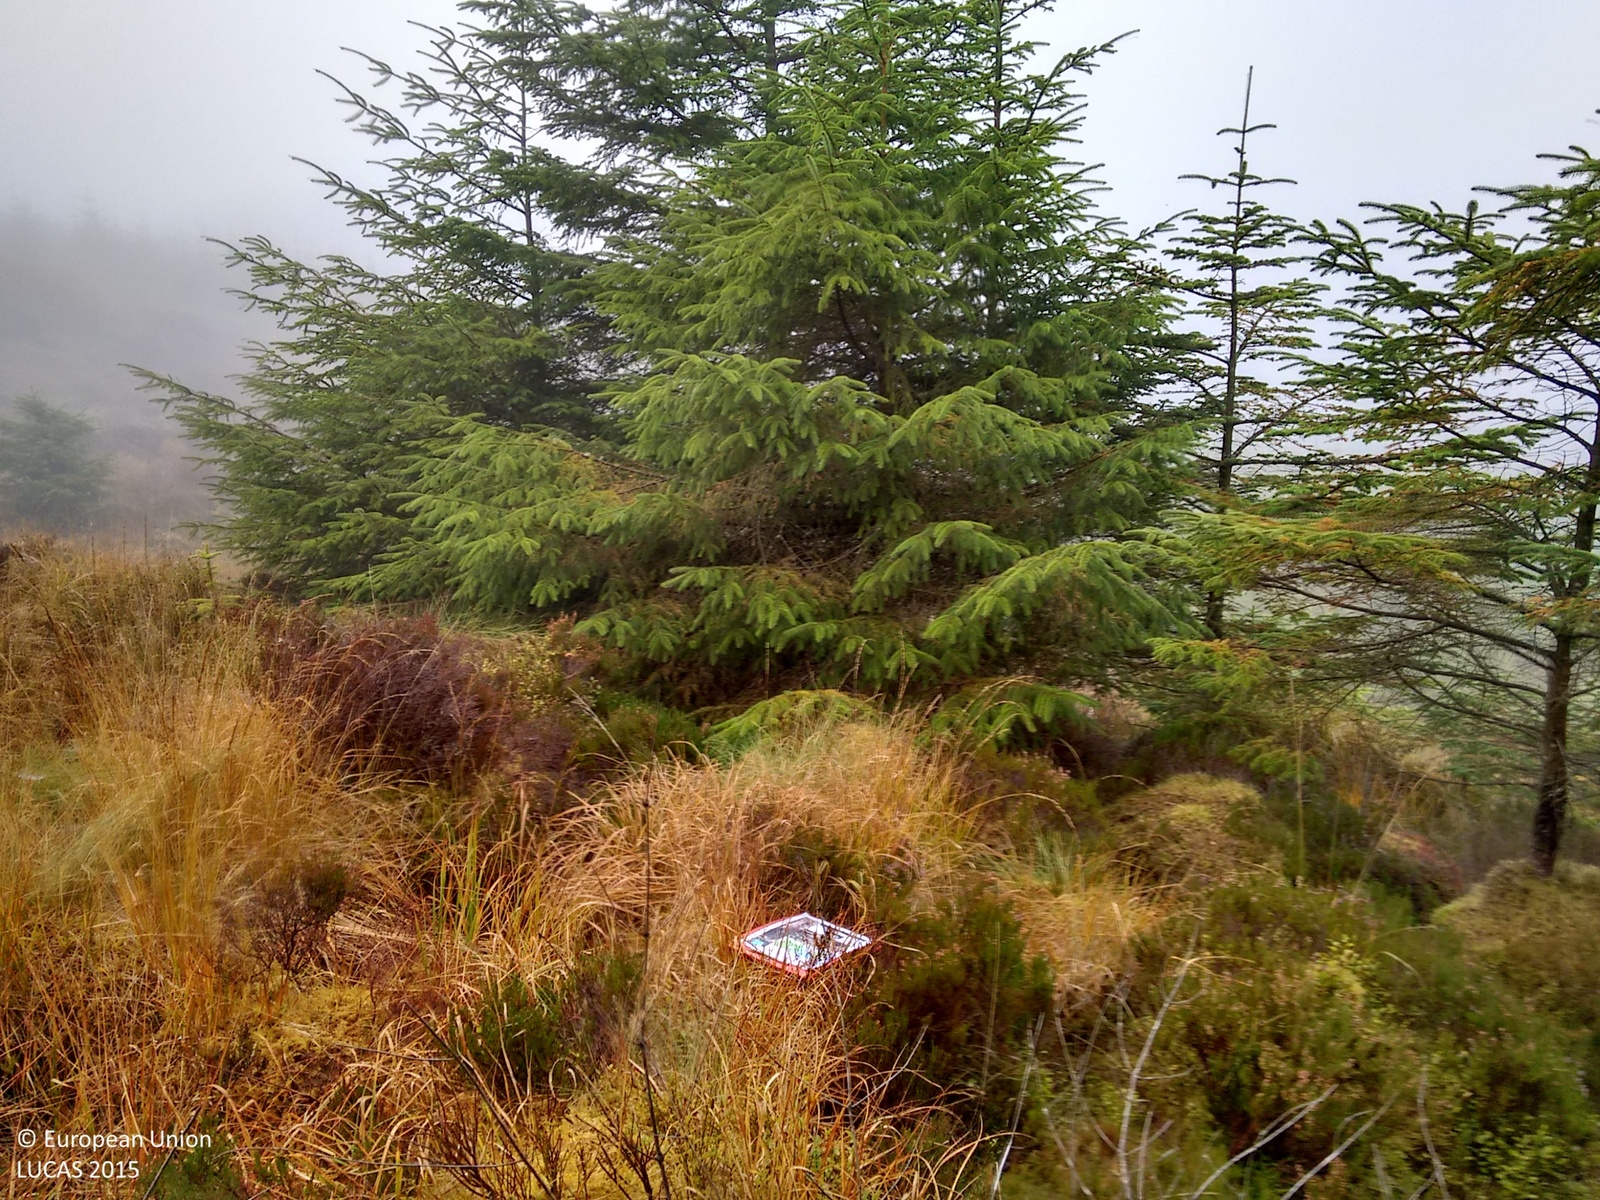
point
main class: Woodland
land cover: Spruce dominated coniferous woodland
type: exotic forest
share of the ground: > 75 %
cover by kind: coniferous forest trees 100 %
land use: Forestry
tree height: > 5 m
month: October
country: GB
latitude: 54.4523
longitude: -7.8908
